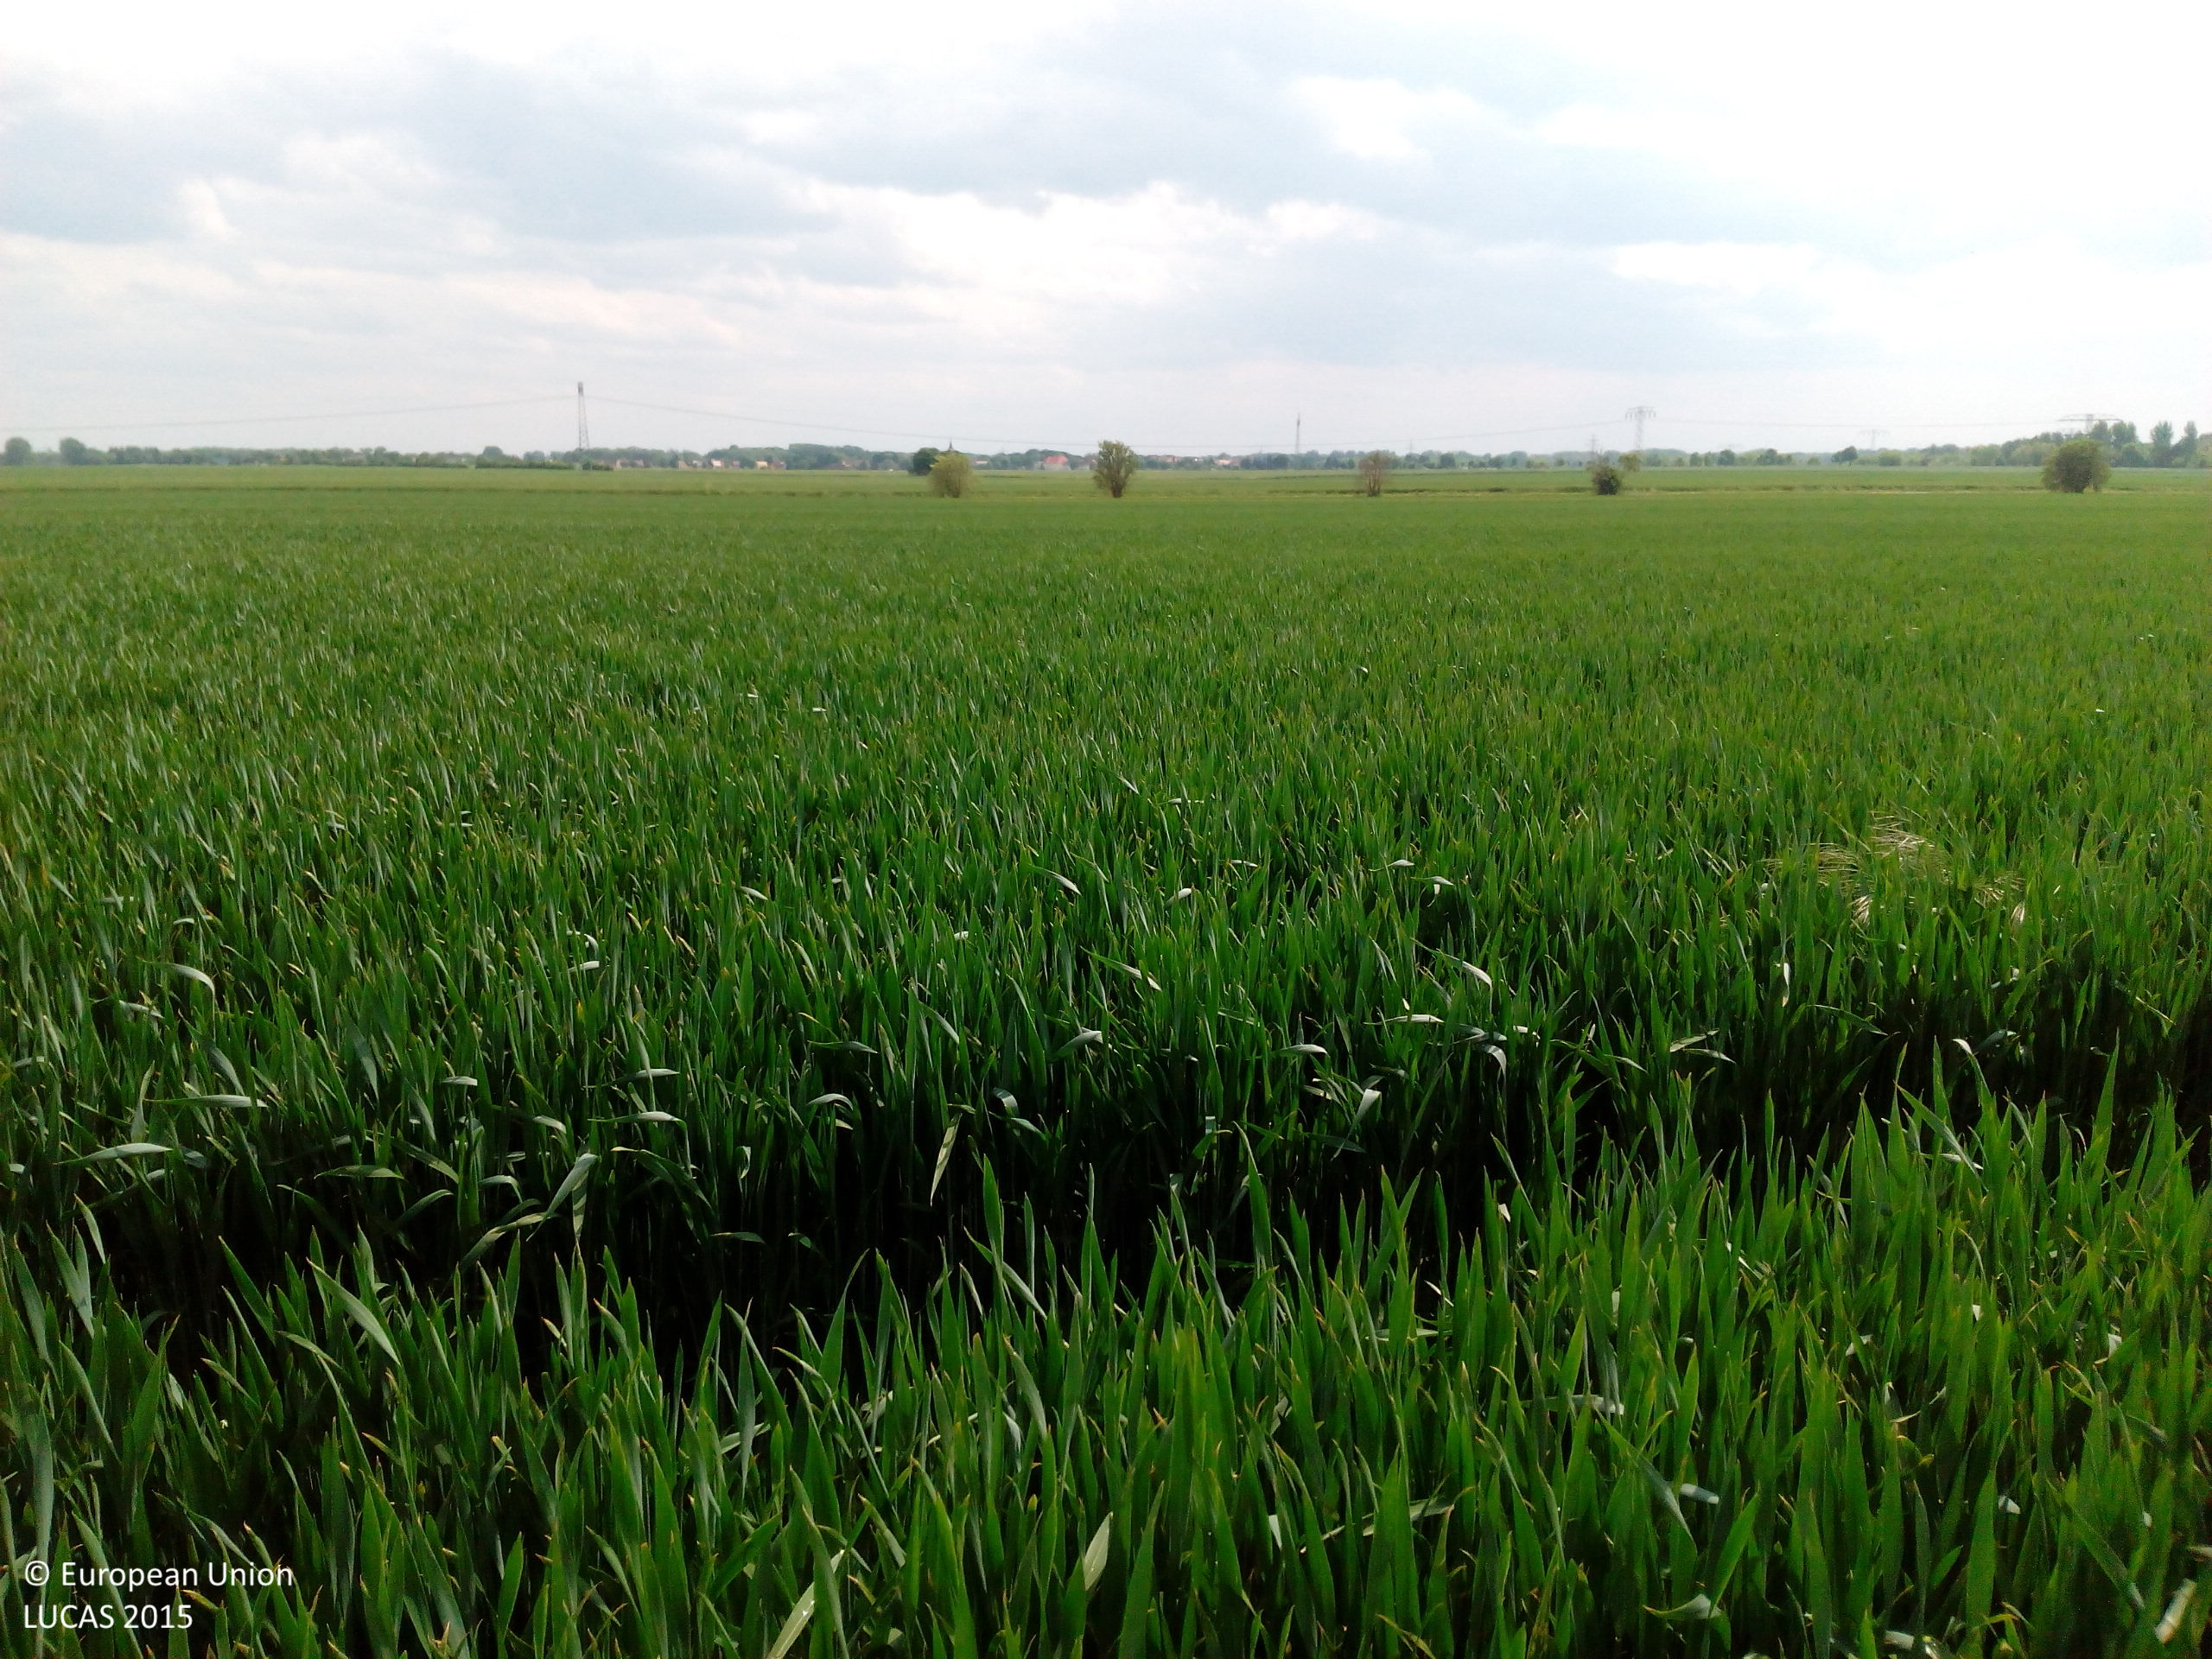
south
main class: Cropland
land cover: Common wheat
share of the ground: > 75 %
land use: Agriculture (excluding fallow land and kitchen gardens)
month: May
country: DE
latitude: 51.6757
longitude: 12.0965
